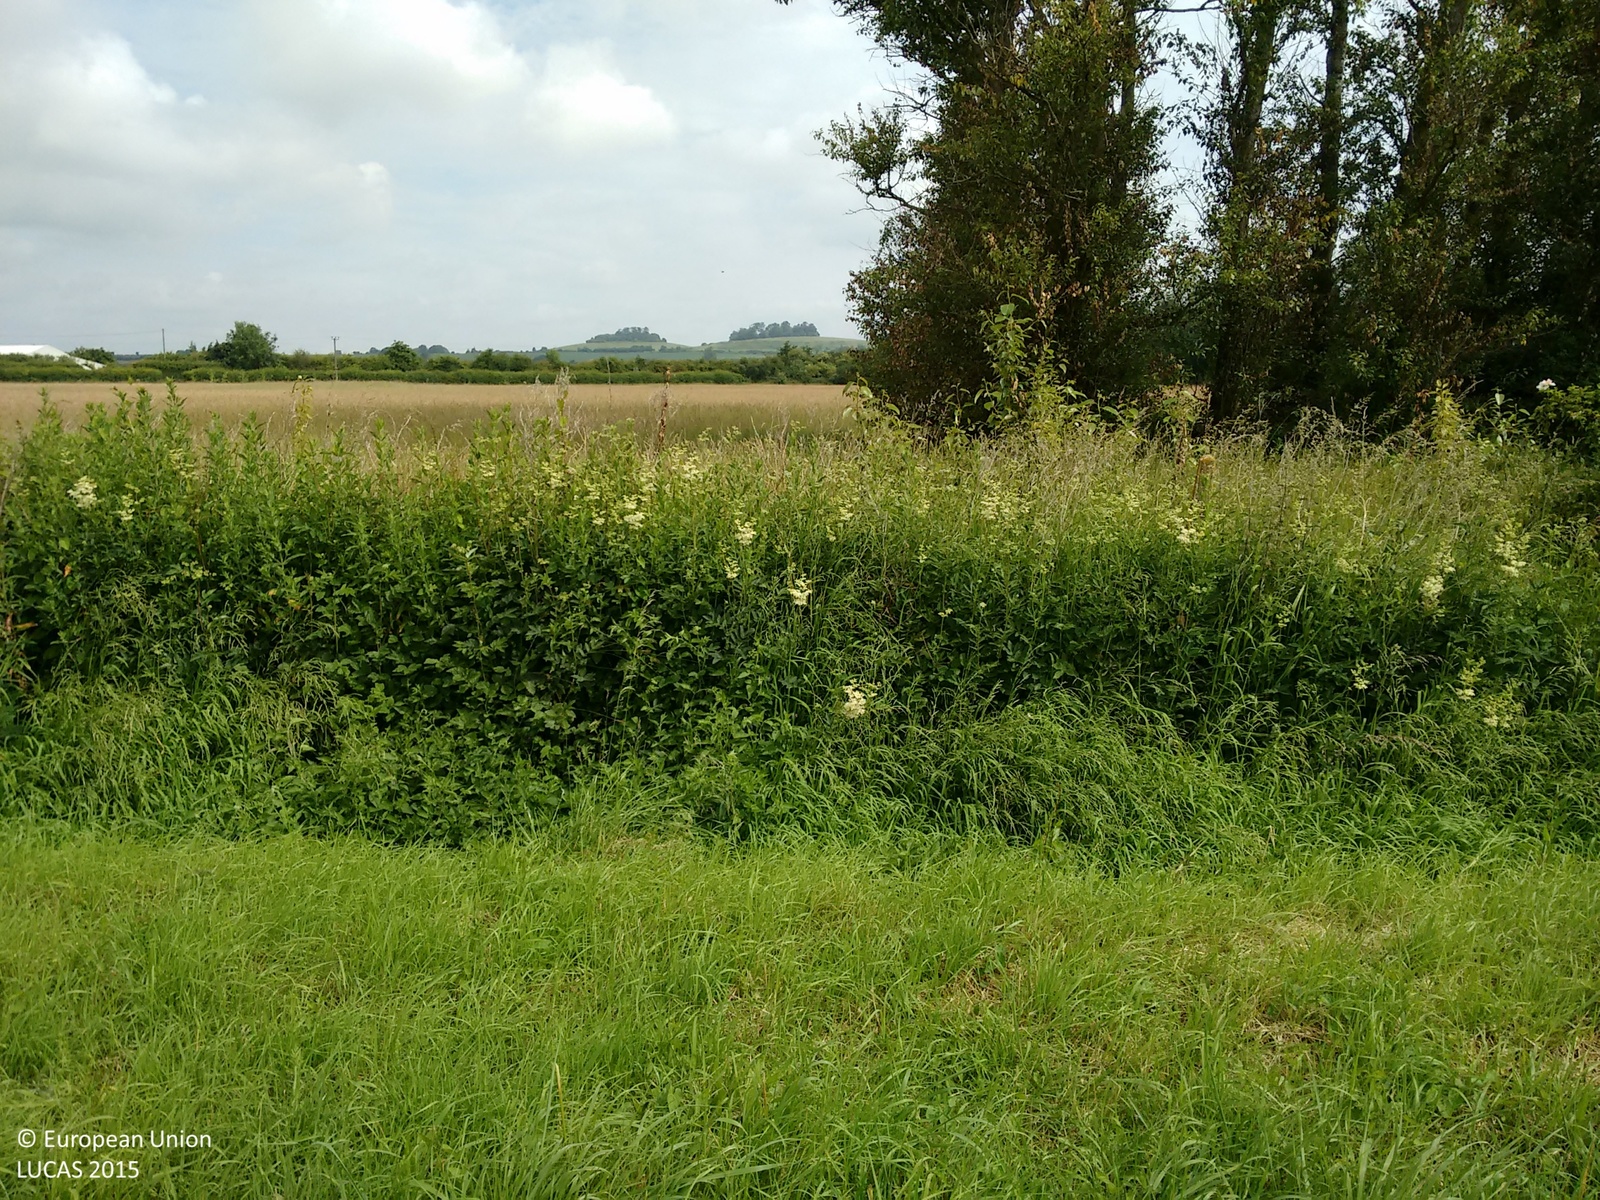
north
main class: Cropland
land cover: Common wheat
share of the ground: > 75 %
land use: Agriculture (excluding fallow land and kitchen gardens)
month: June
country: GB
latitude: 51.6114
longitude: -1.1807
